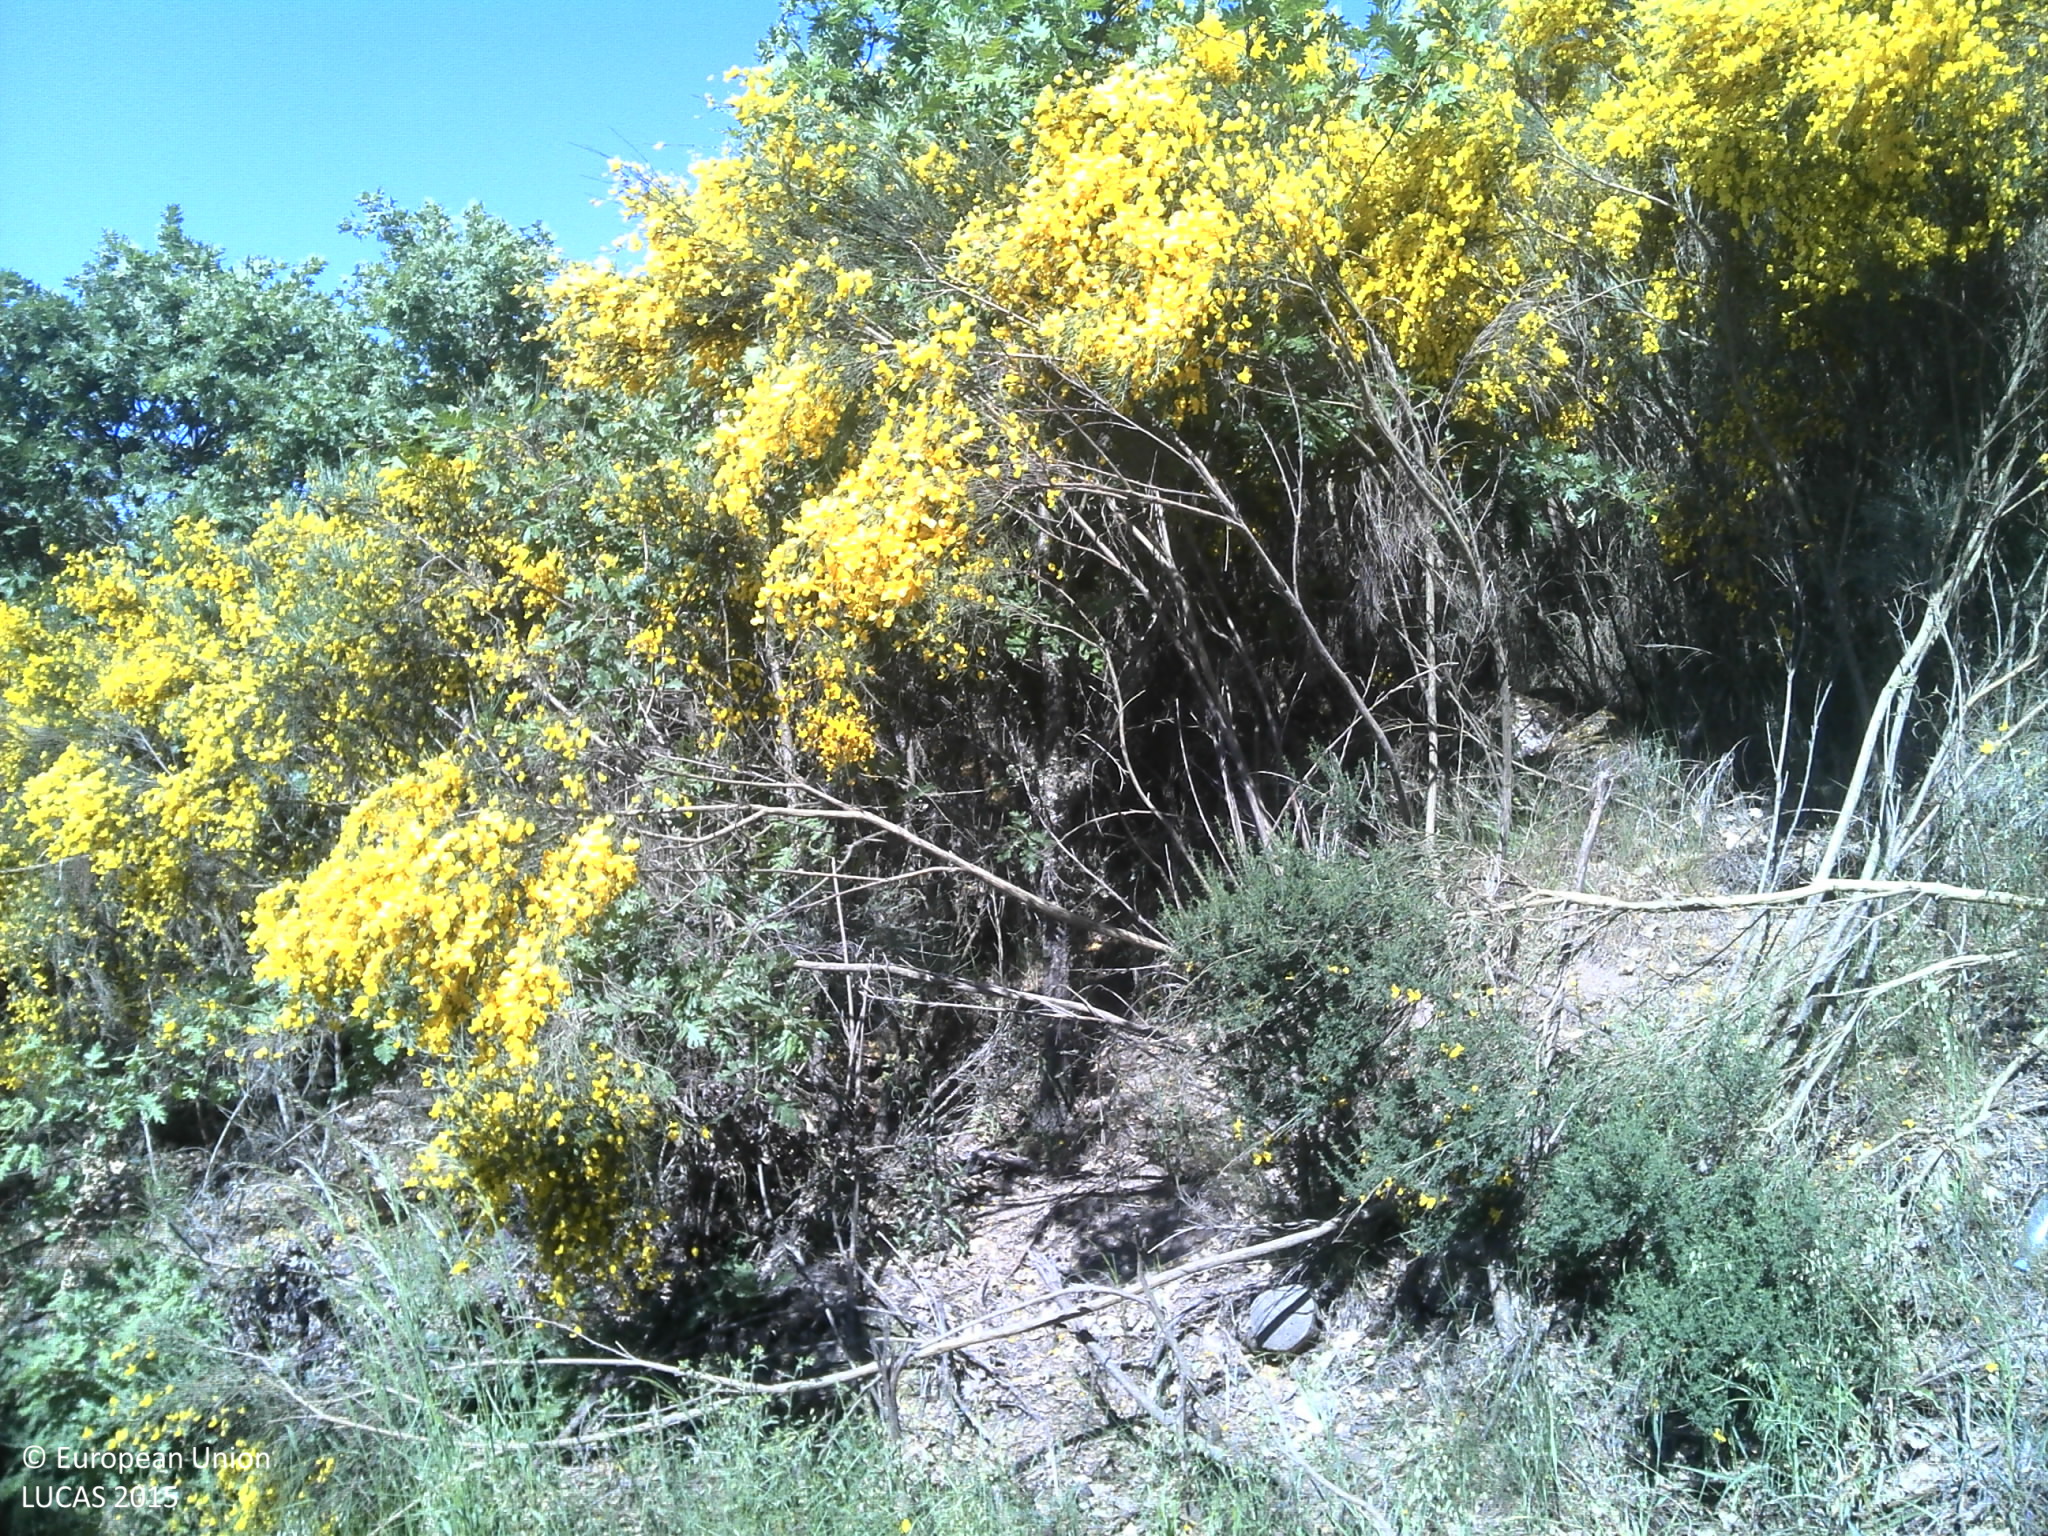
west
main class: Shrubland
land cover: Shrubland without tree cover
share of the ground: > 75 %
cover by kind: shrubs 80 %, herbaceous plants 10 %
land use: Semi-natural and natural areas not in use
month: May
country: PT
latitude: 40.5717
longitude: -7.2456
